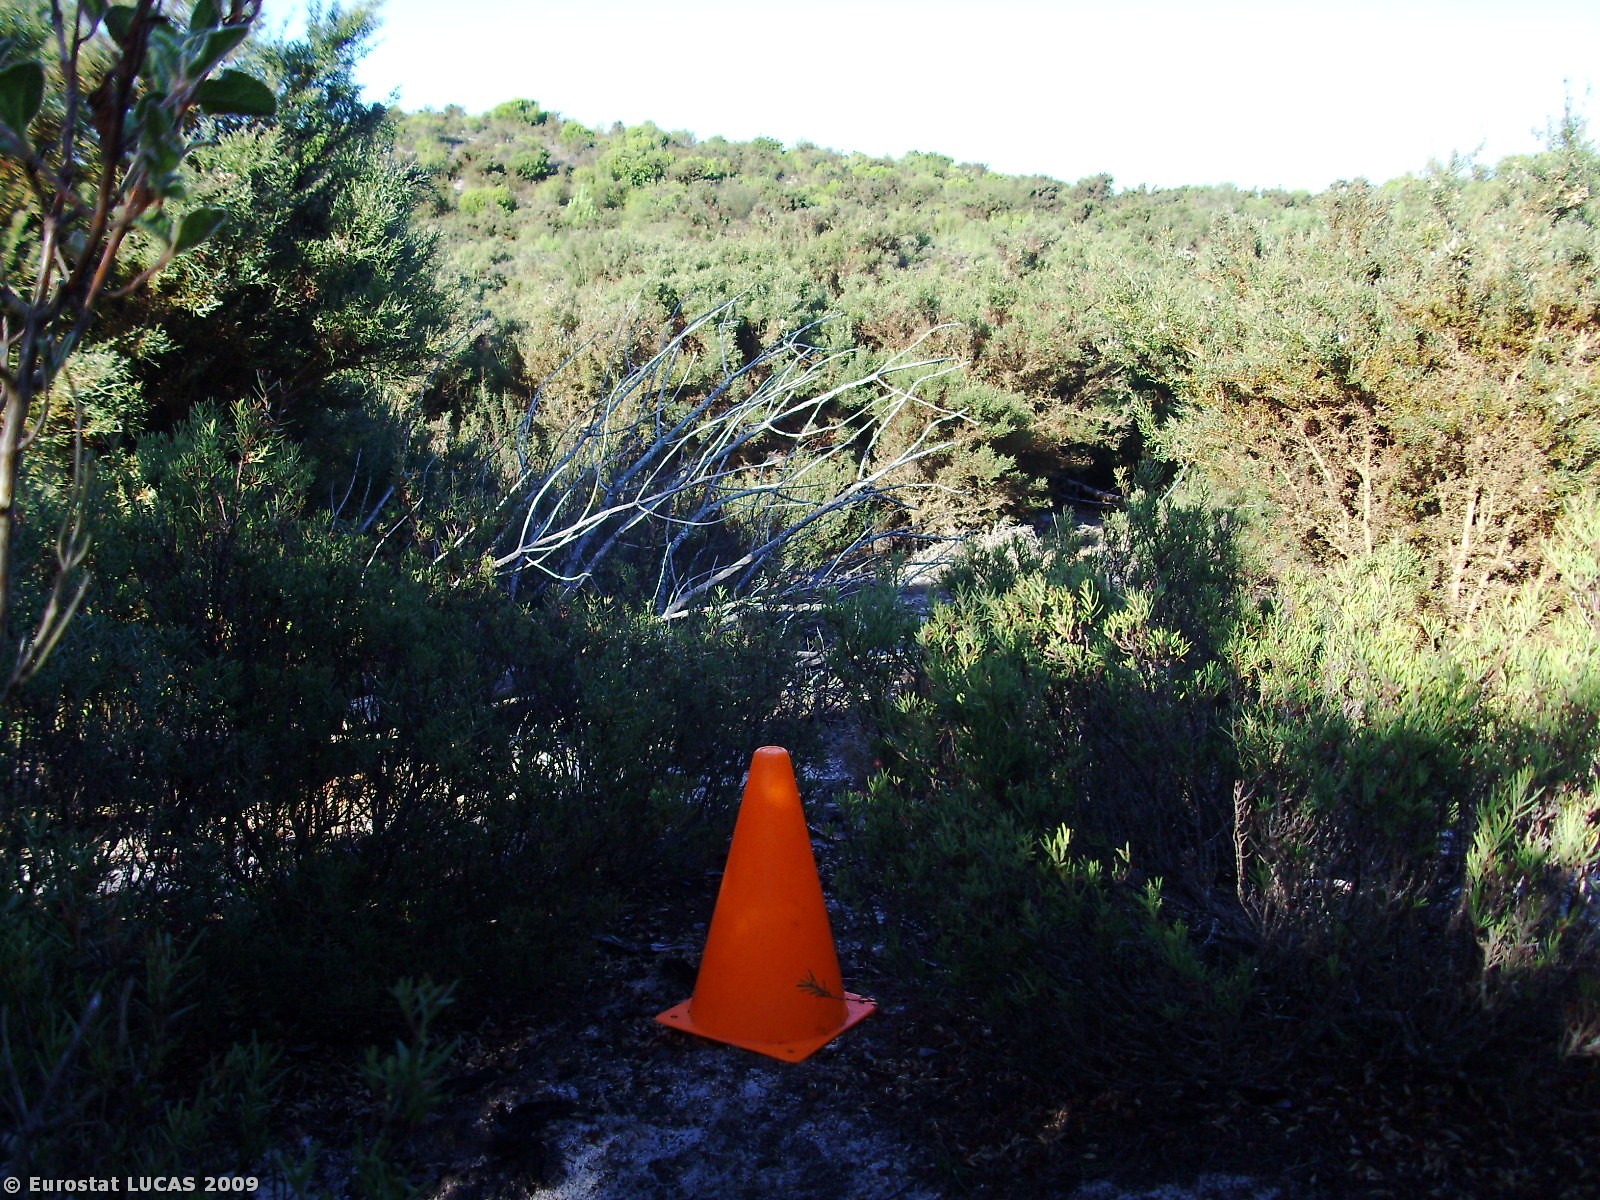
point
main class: Shrubland
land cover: Shrubland without tree cover
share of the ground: > 75 %
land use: Nature reserves
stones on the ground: < 10 %
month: July
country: PT
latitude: 39.8253
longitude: -8.9608
